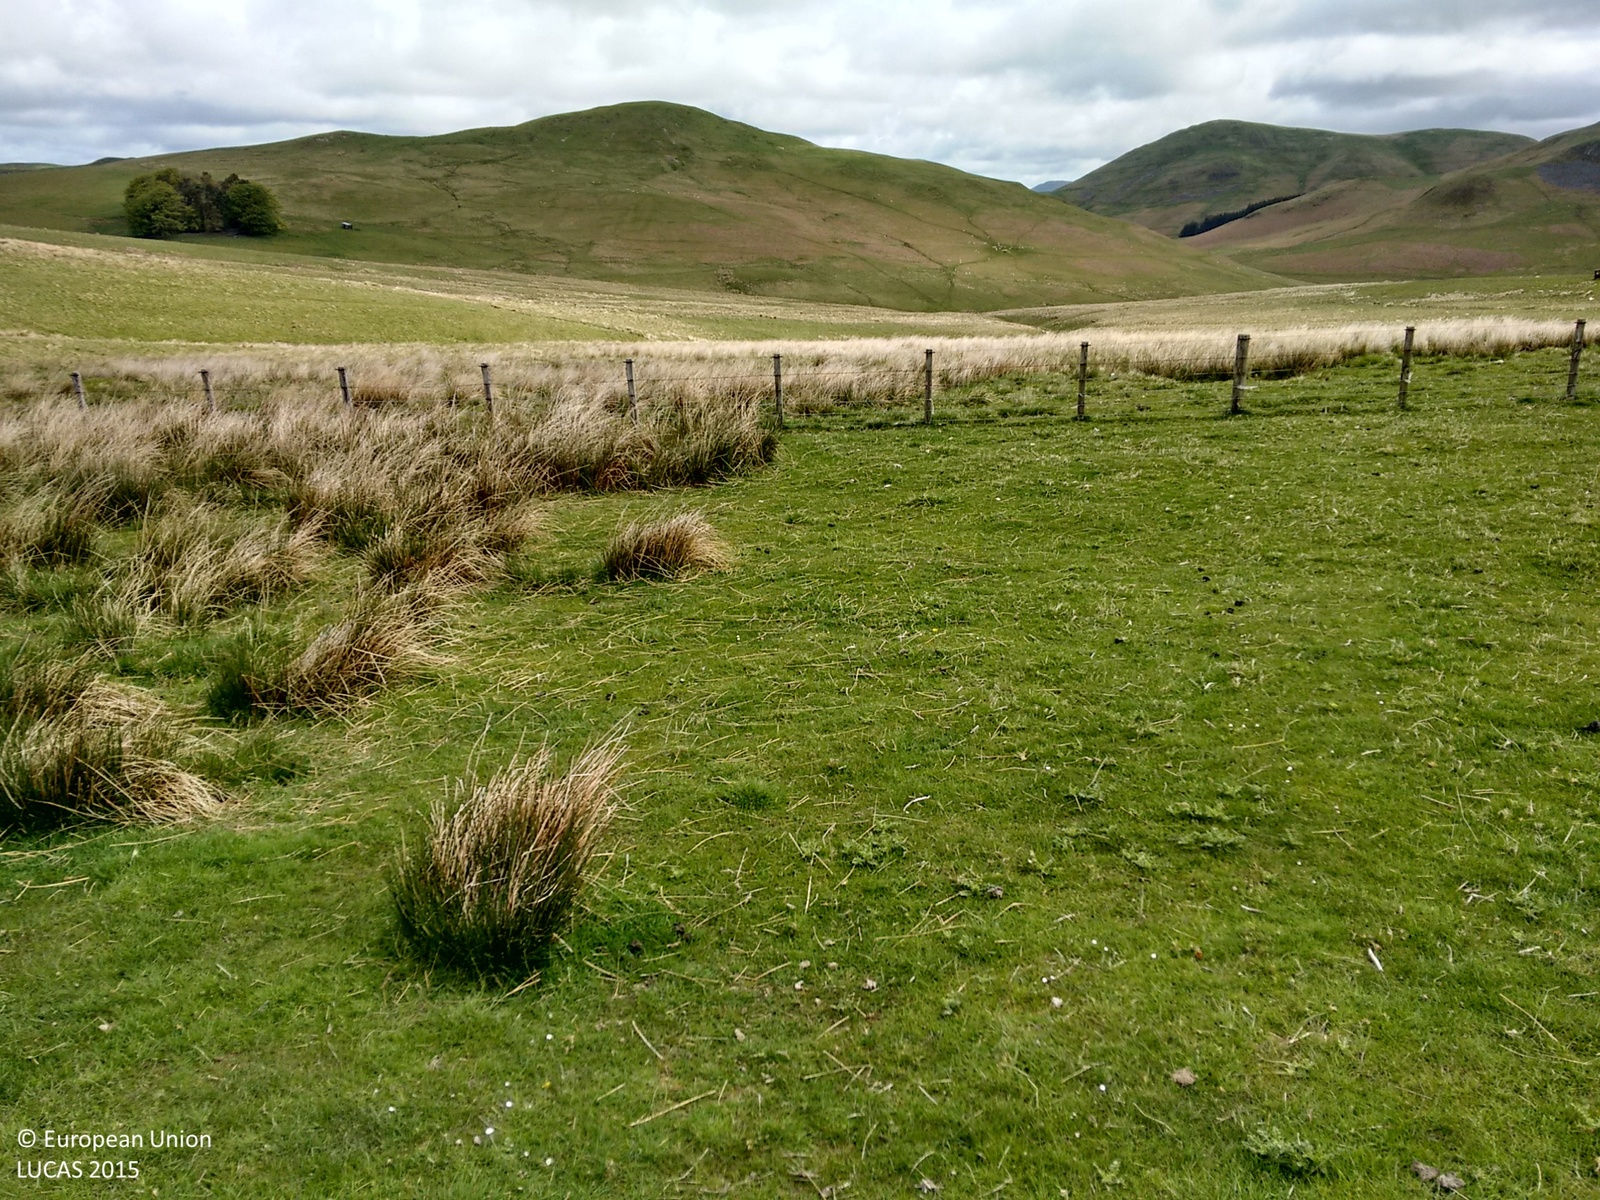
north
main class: Grassland
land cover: Grassland without tree/shrub cover
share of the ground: > 75 %
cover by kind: herbaceous plants 100 %
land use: Agriculture (excluding fallow land and kitchen gardens)
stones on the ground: < 10 %
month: May
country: GB
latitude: 55.3843
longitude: -2.3872
